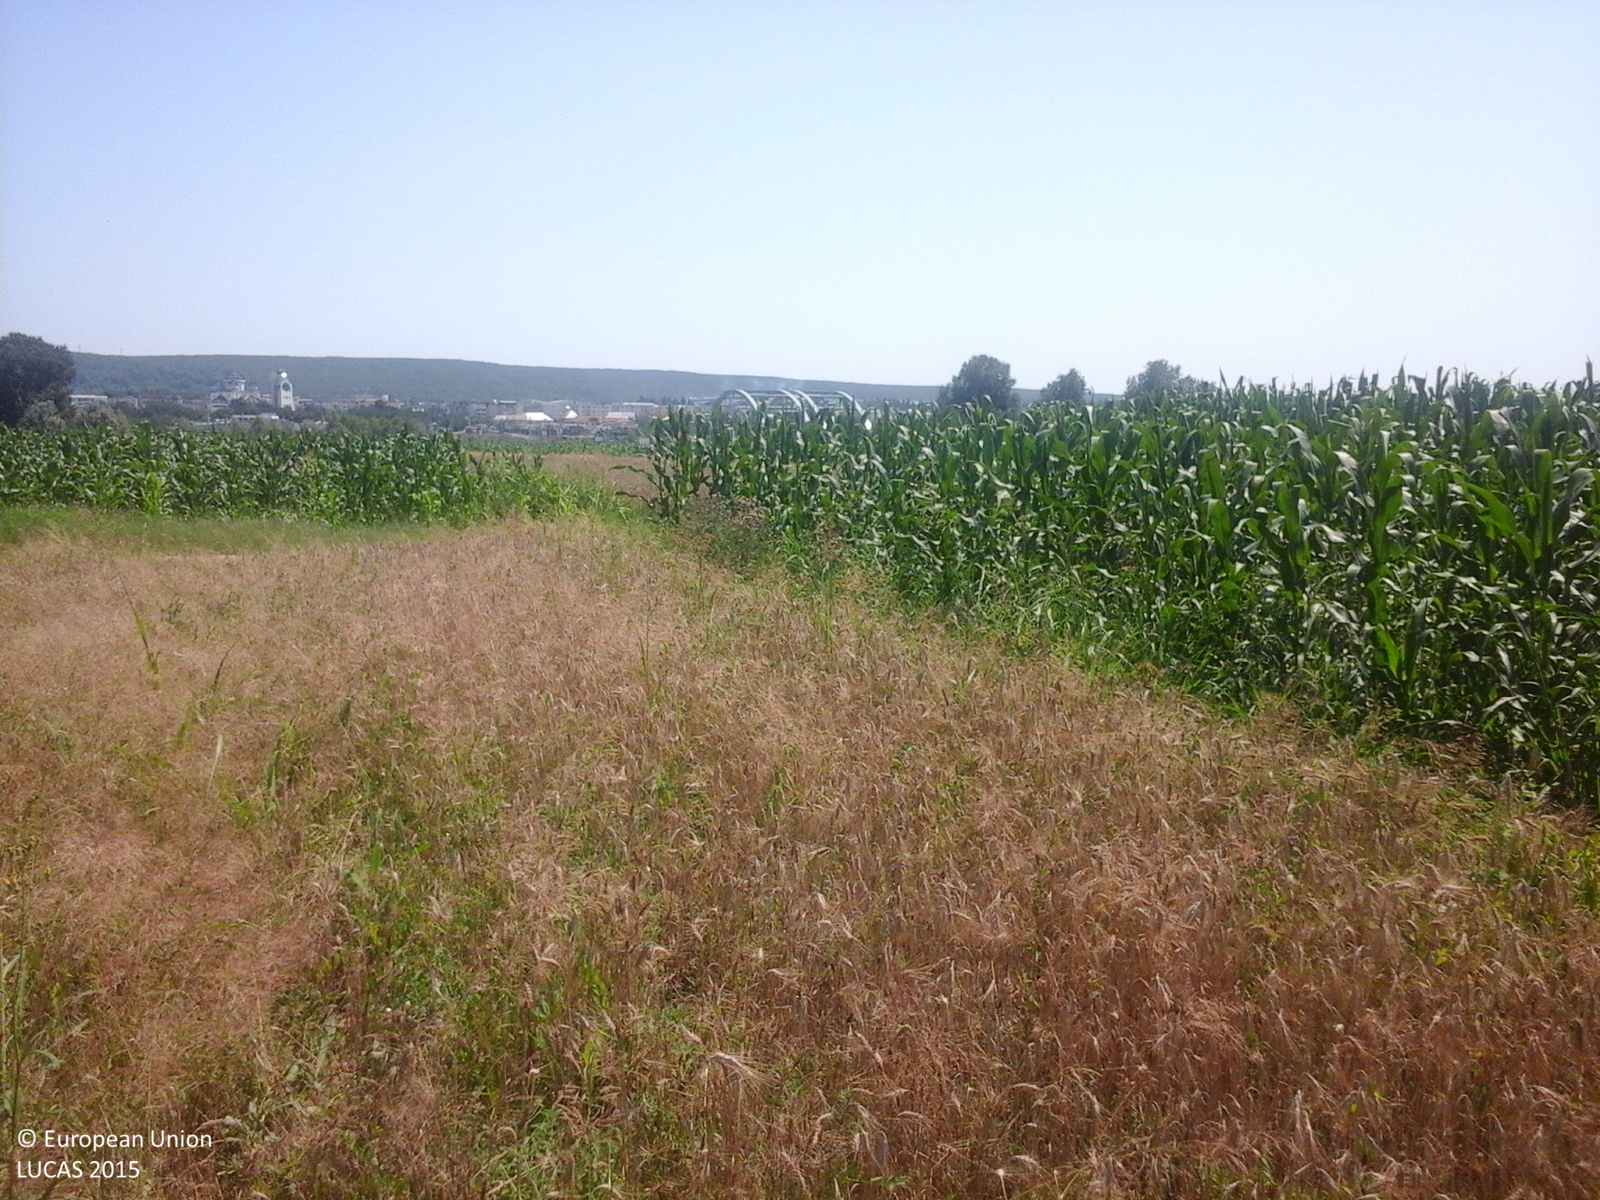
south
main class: Cropland
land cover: Common wheat
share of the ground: > 75 %
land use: Agriculture (excluding fallow land and kitchen gardens)
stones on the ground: < 10 %
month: July
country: RO
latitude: 44.9665
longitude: 24.9303
